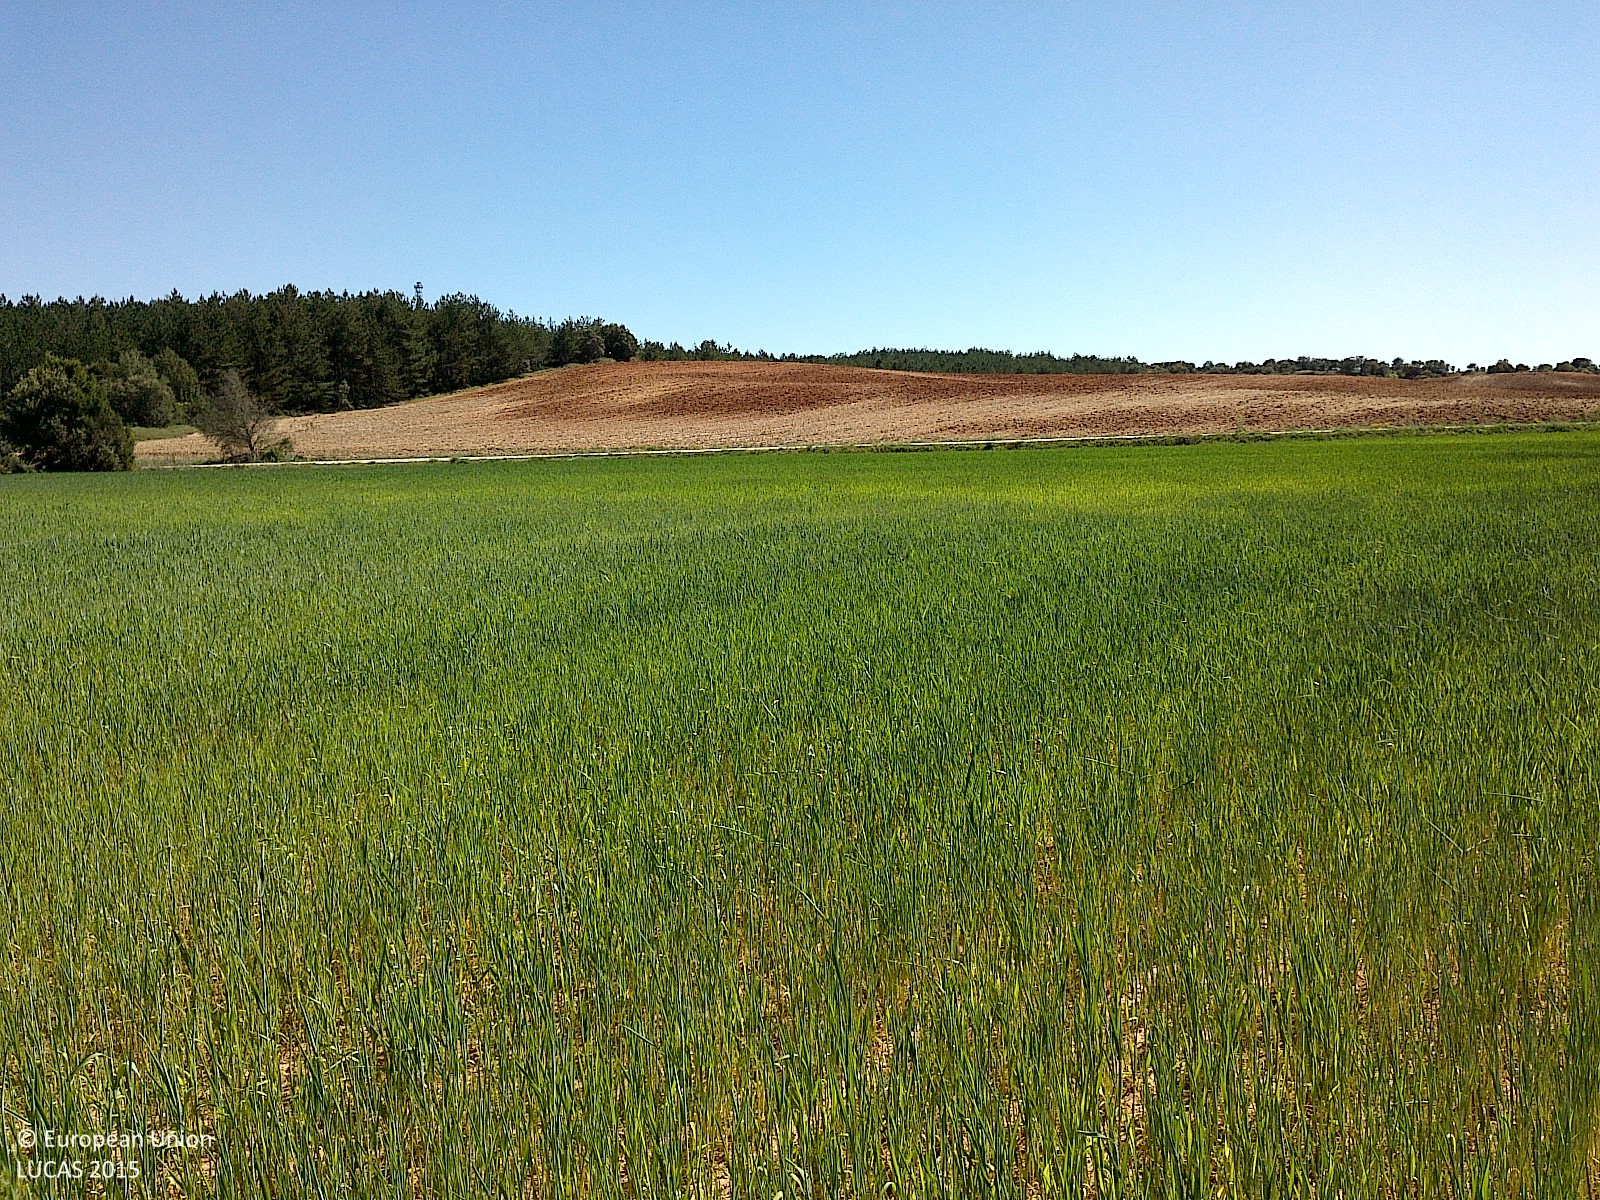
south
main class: Cropland
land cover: Barley
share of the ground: > 75 %
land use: Agriculture (excluding fallow land and kitchen gardens)
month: May
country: ES
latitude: 41.6147
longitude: -3.1129
